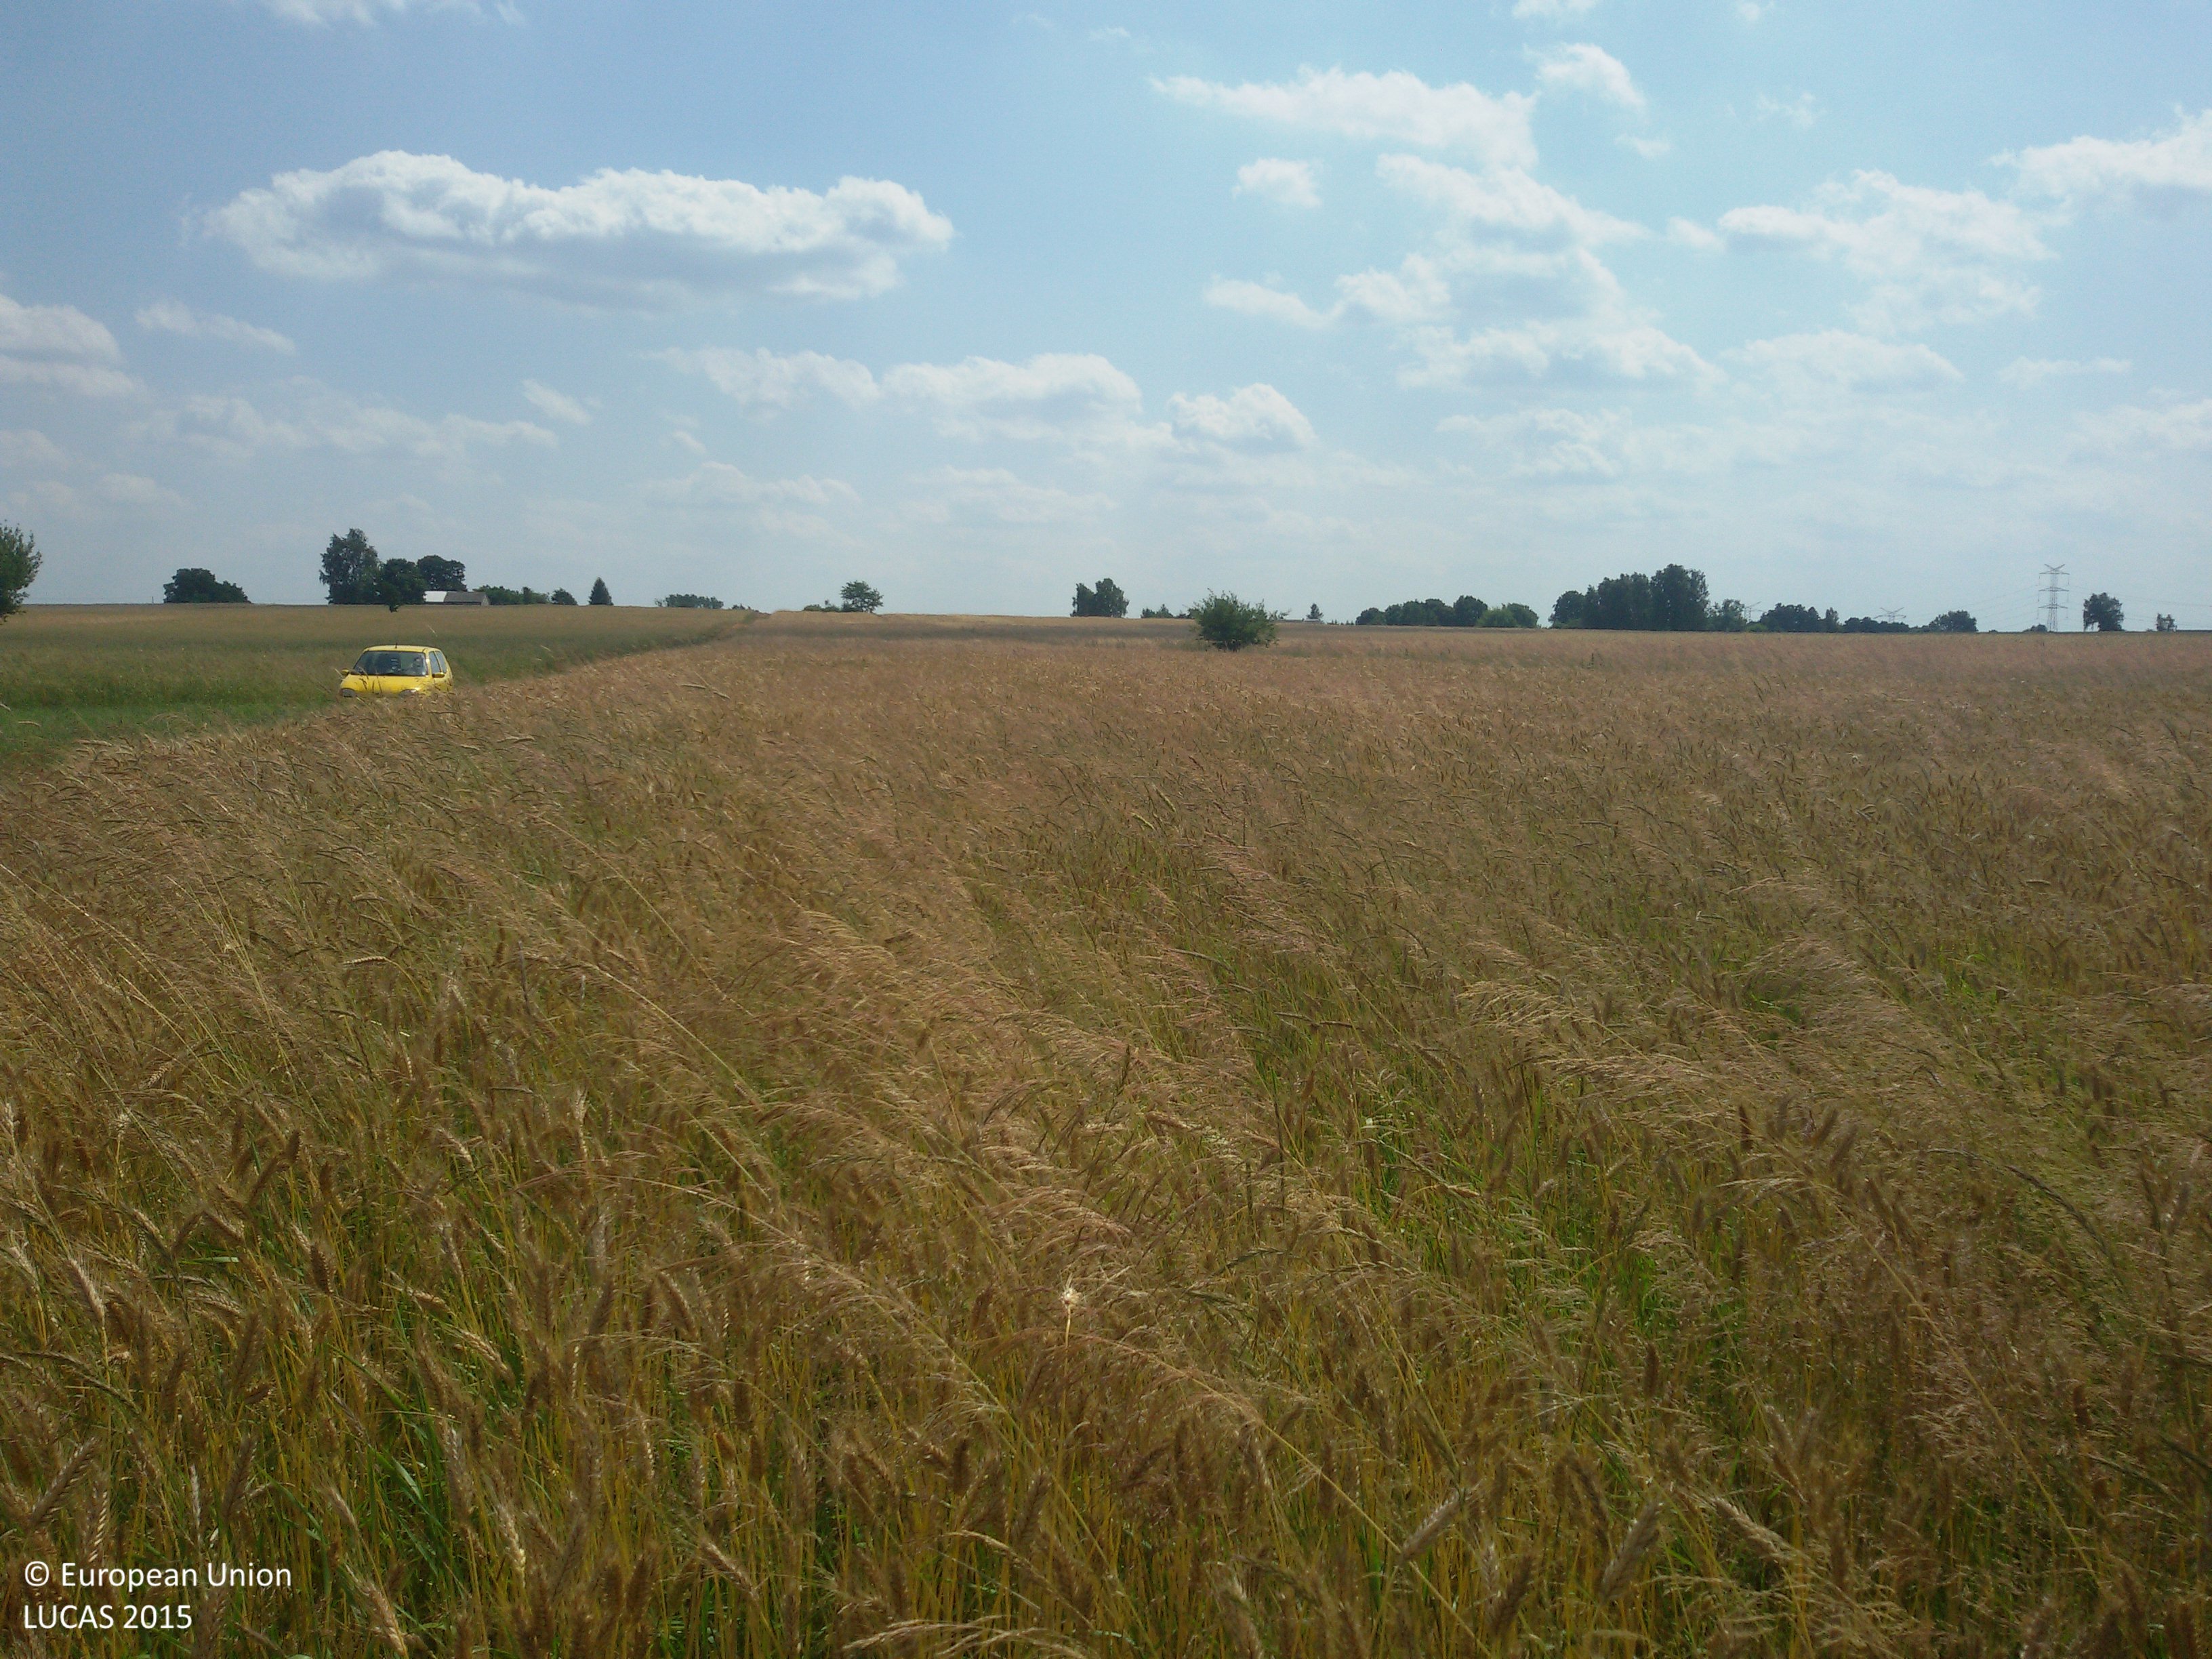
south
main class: Cropland
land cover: Triticale
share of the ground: > 75 %
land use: Agriculture (excluding fallow land and kitchen gardens)
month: July
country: PL
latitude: 51.7909
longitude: 19.7879
